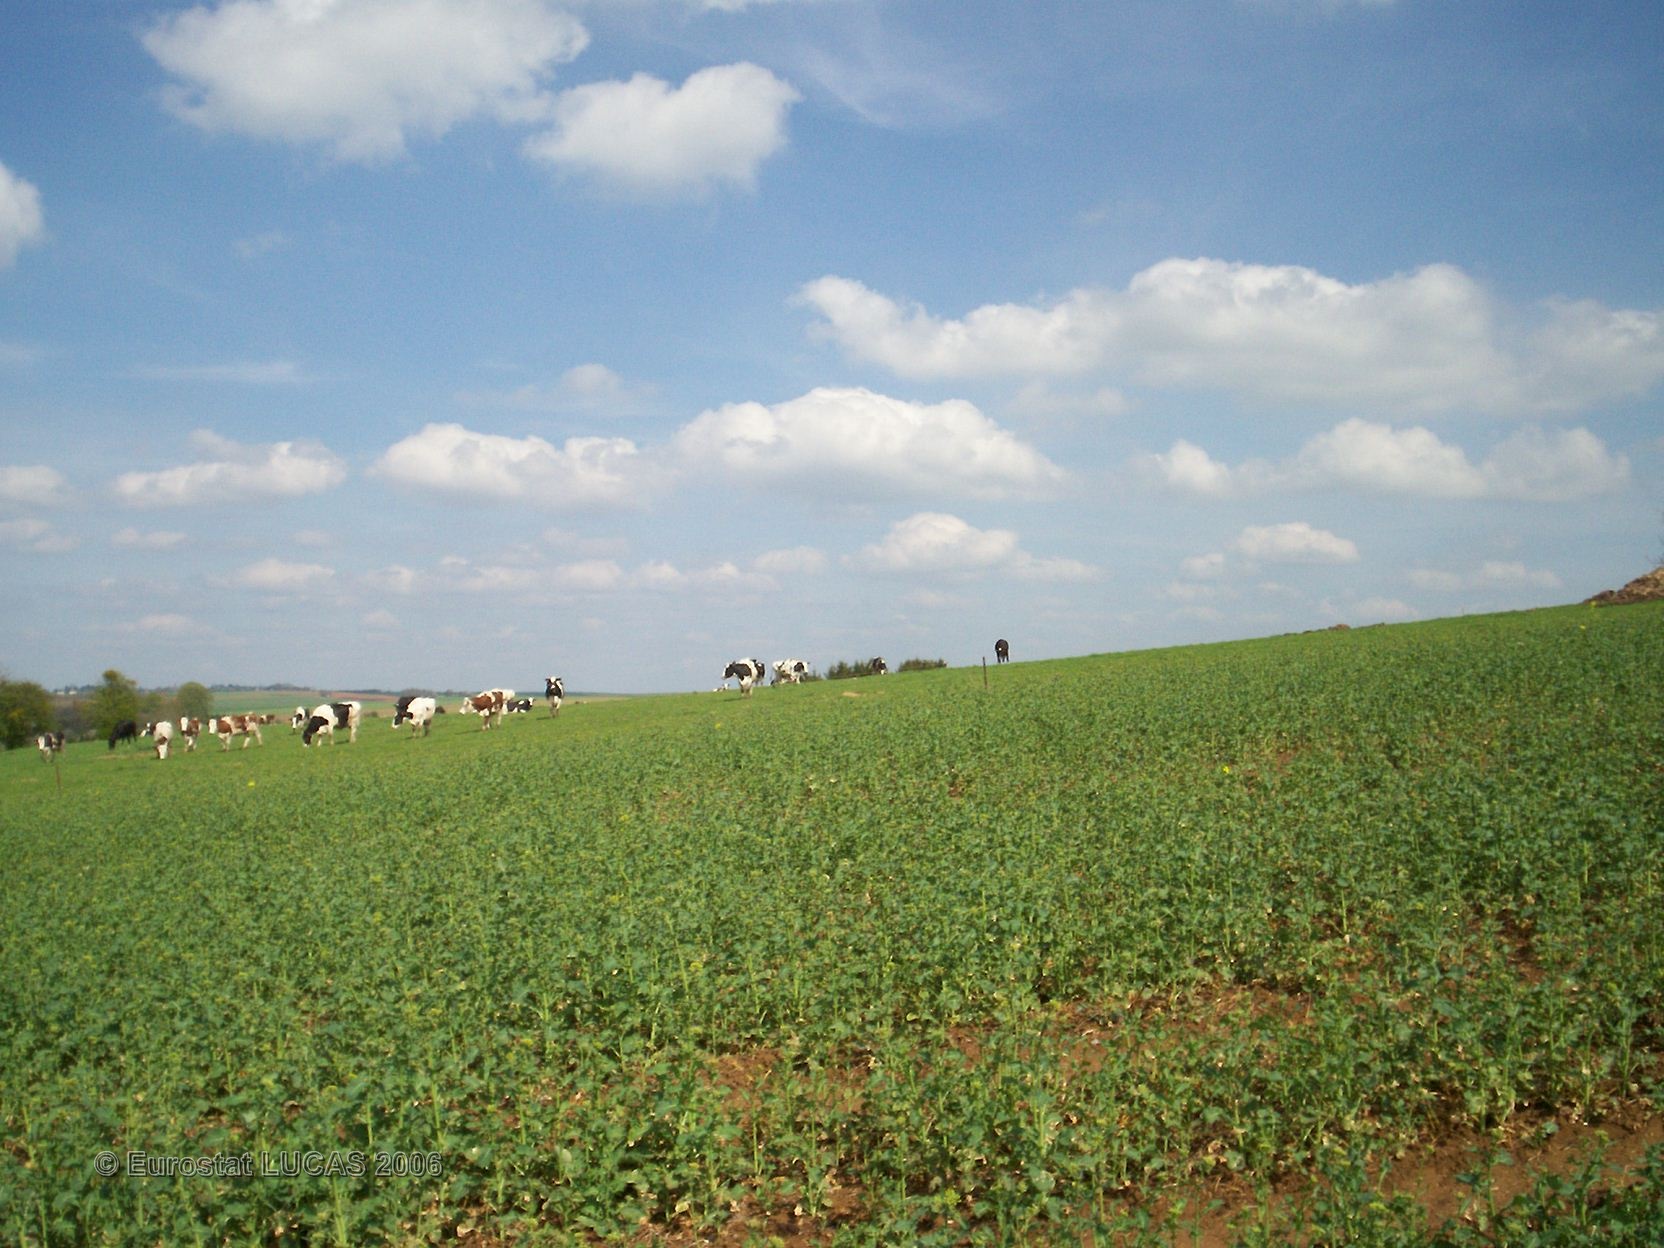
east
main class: Cropland
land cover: Rape and turnip rape
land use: Agriculture (excluding fallow land and kitchen gardens)
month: May
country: FR
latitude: 49.8438
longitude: 4.3080
